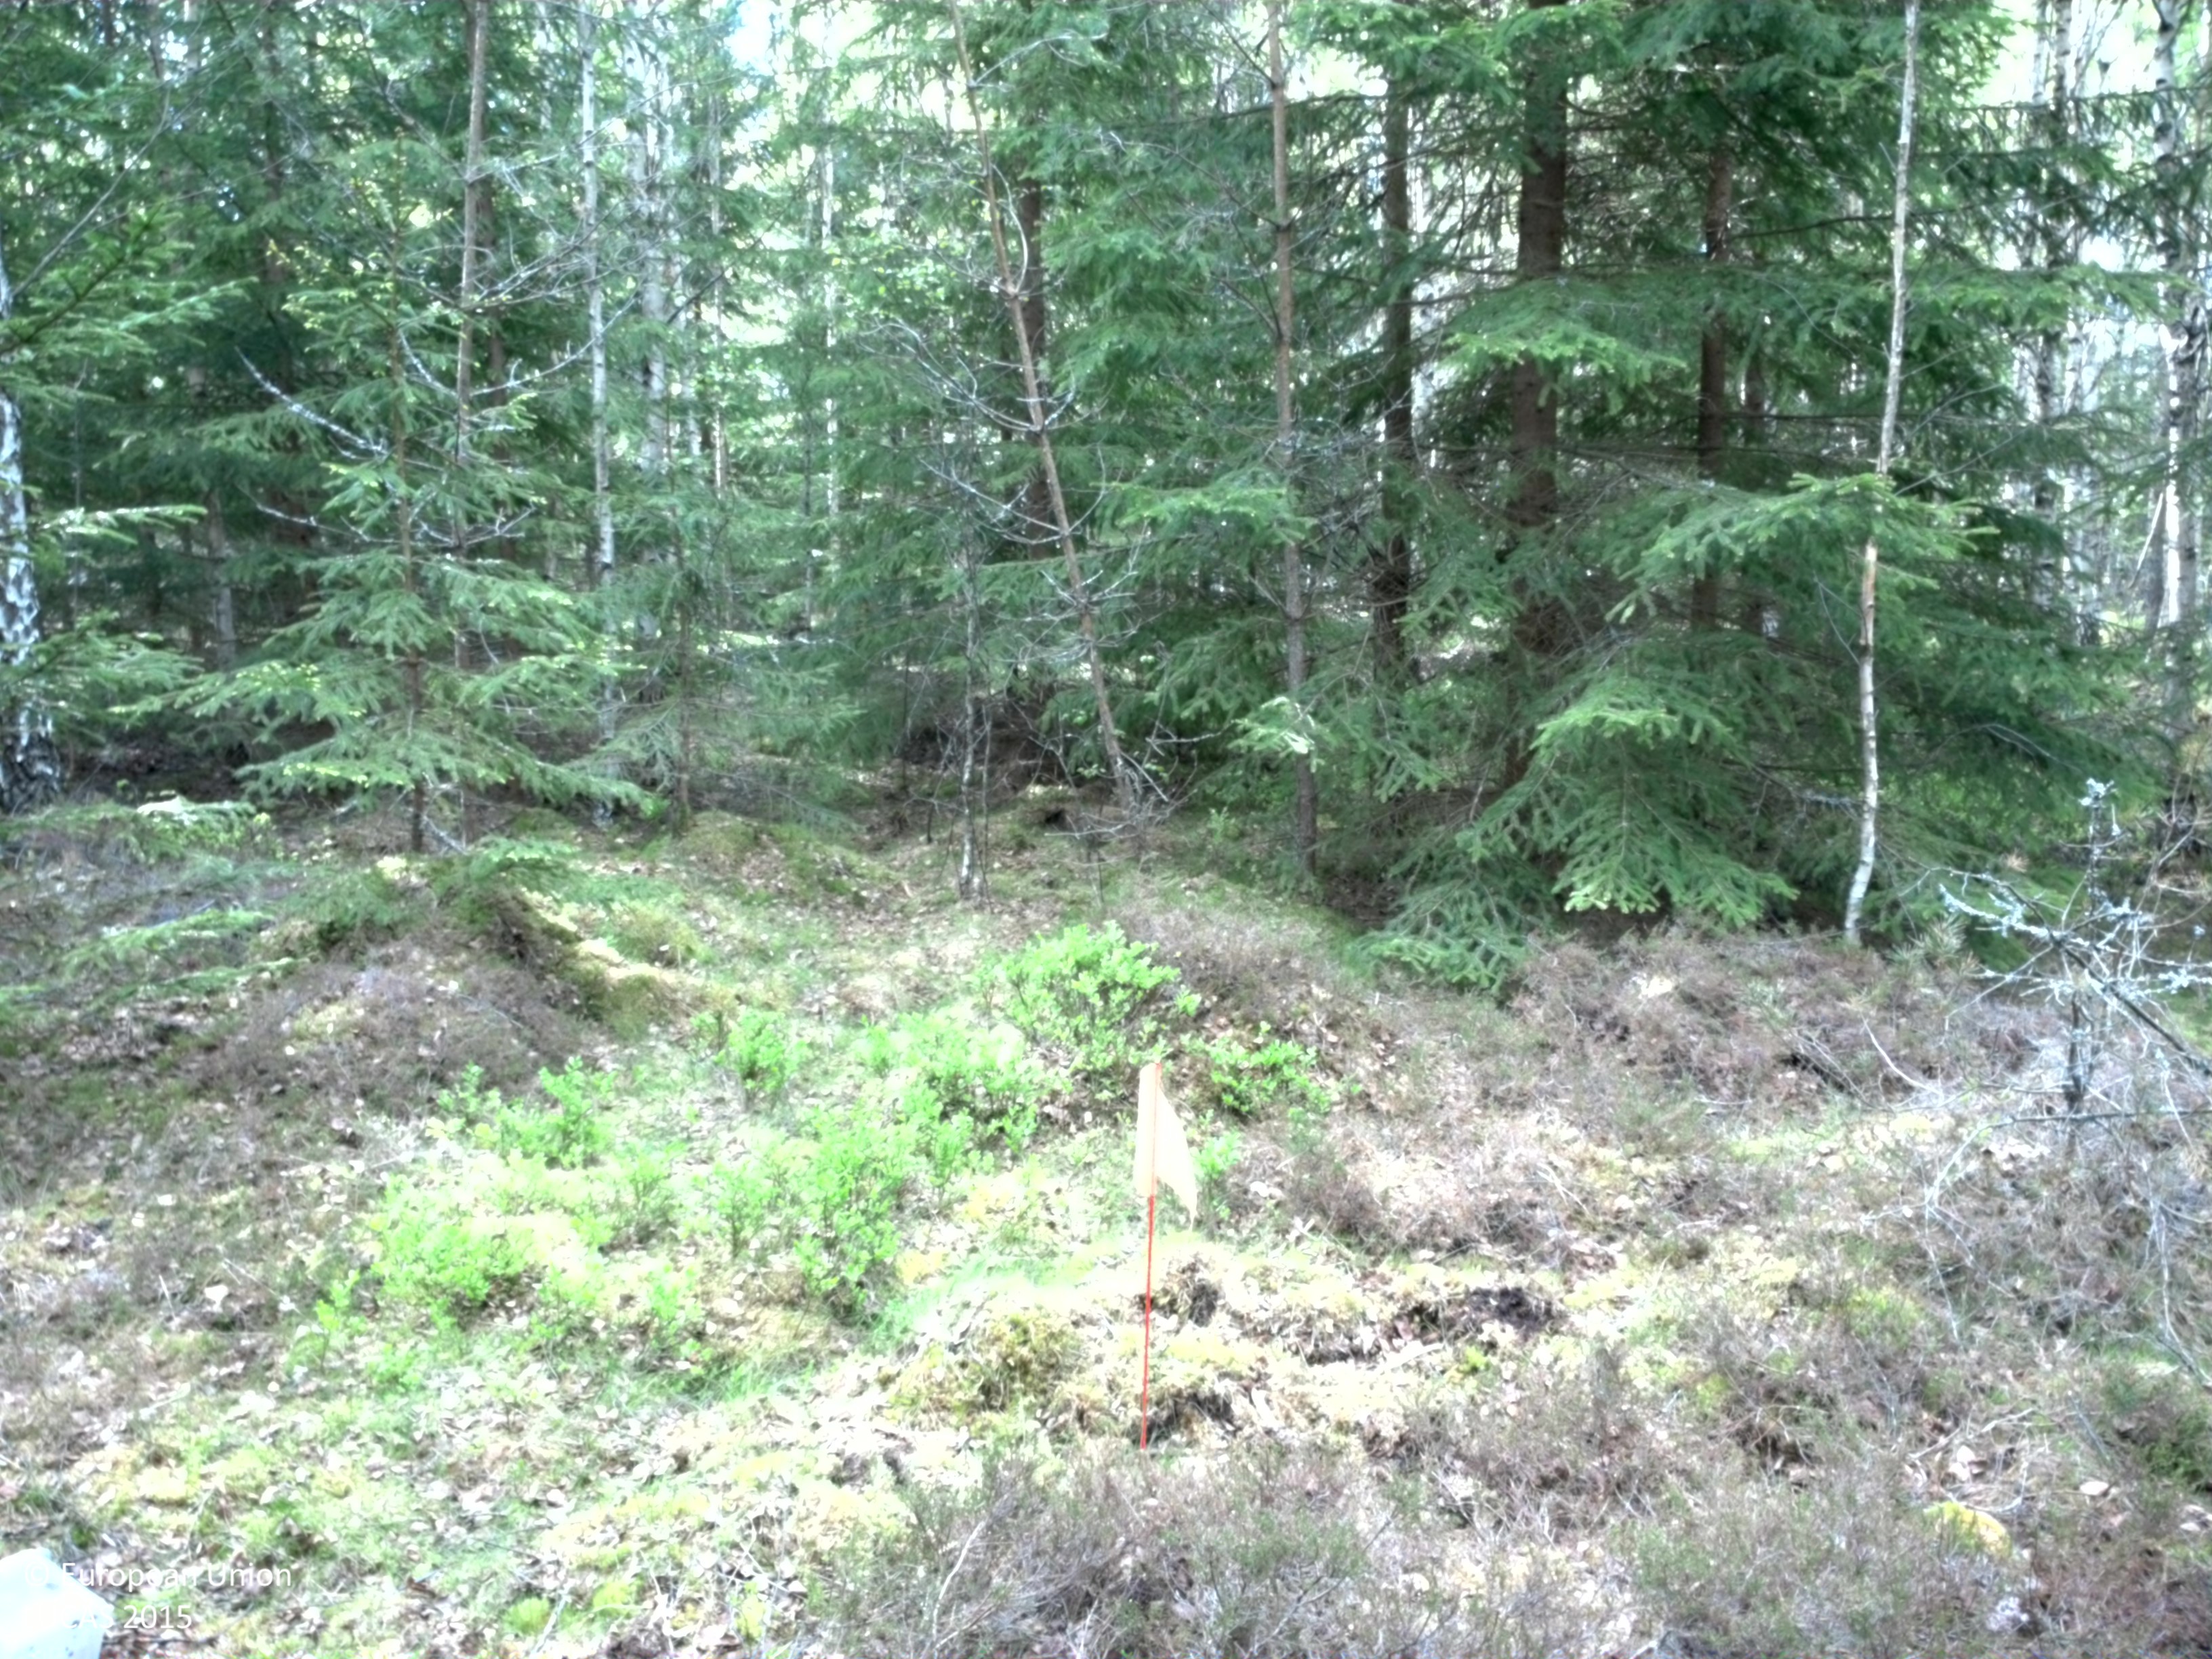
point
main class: Woodland
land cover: Spruce dominated mixed woodland
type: boreal forest
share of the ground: > 75 %
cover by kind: coniferous forest trees 40 %, broadleaved forest trees 40 %, lichens and mosses 20 %
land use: Forestry
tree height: > 5 m
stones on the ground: 10 - 25 %
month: May
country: SE
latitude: 56.7254
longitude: 15.3422
